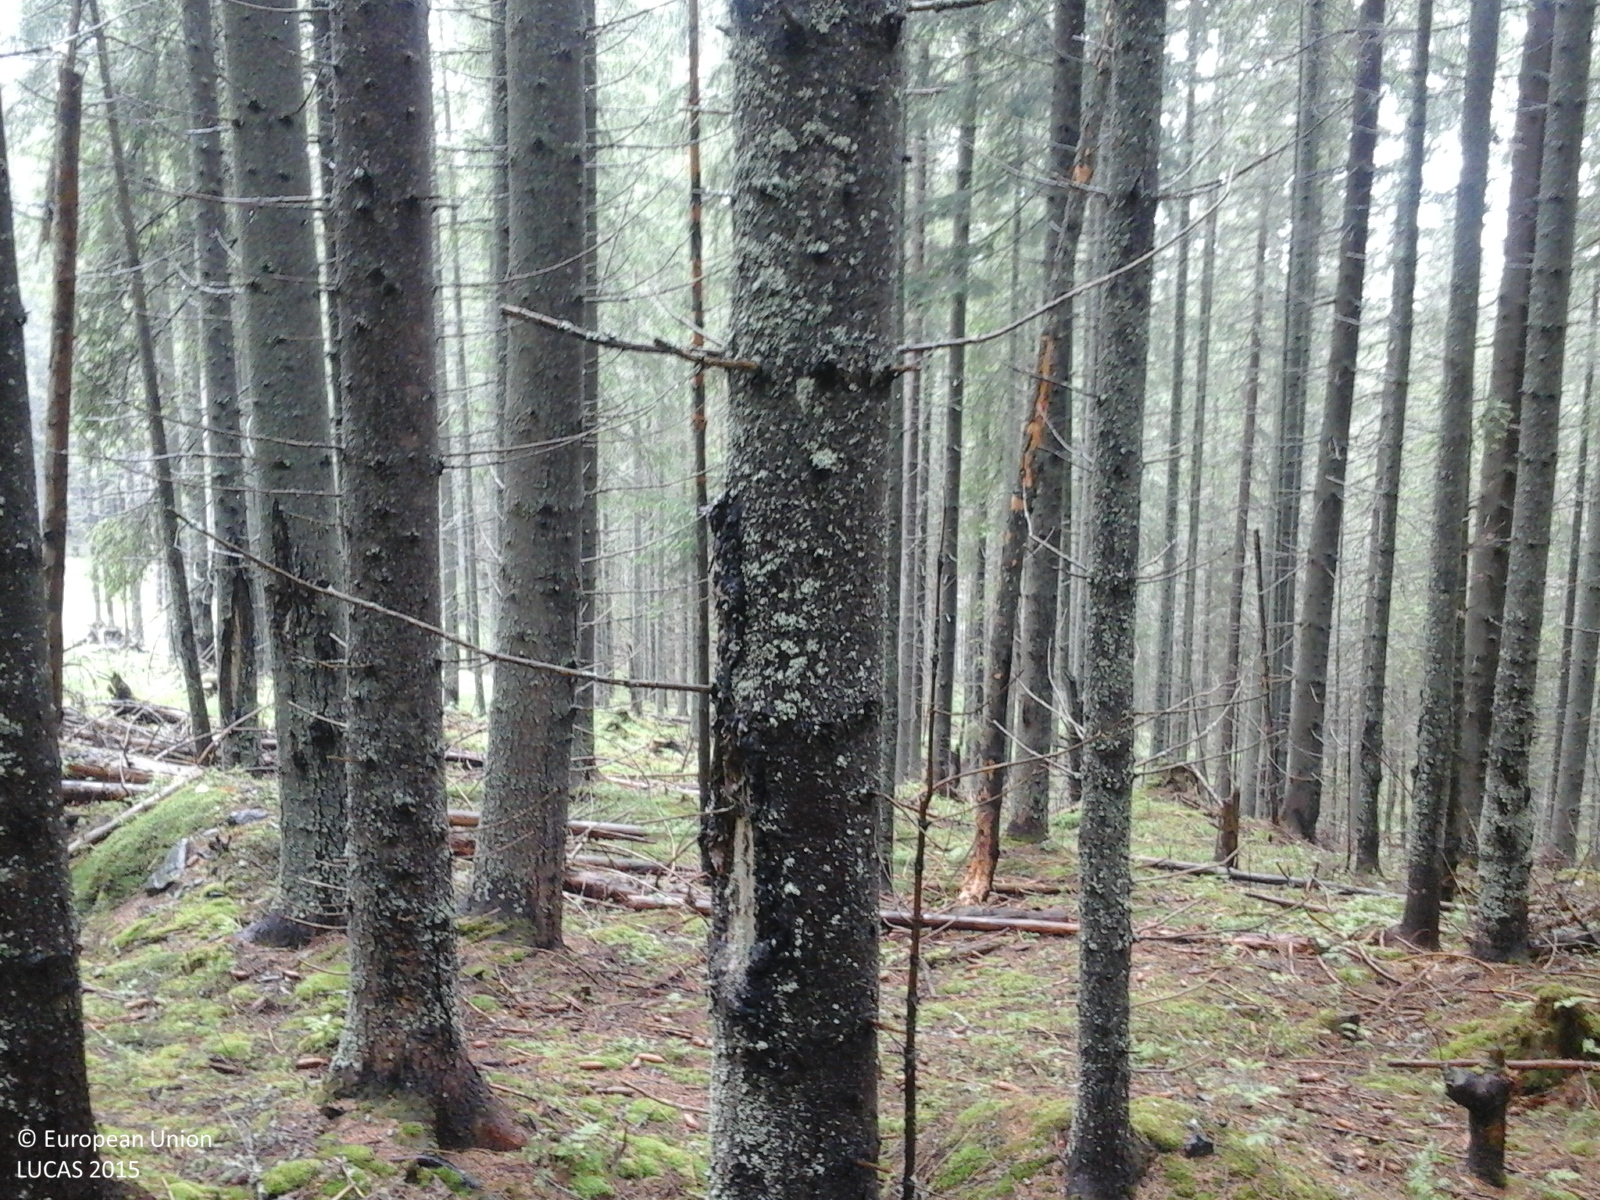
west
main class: Woodland
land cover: Spruce dominated coniferous woodland
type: alpine coniferous forest
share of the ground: > 75 %
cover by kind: coniferous forest trees 90 %, herbaceous plants 5 %, lichens and mosses 5 %
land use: Forestry
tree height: > 5 m
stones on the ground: 10 - 25 %
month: June
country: RO
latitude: 47.4162
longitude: 25.3407
